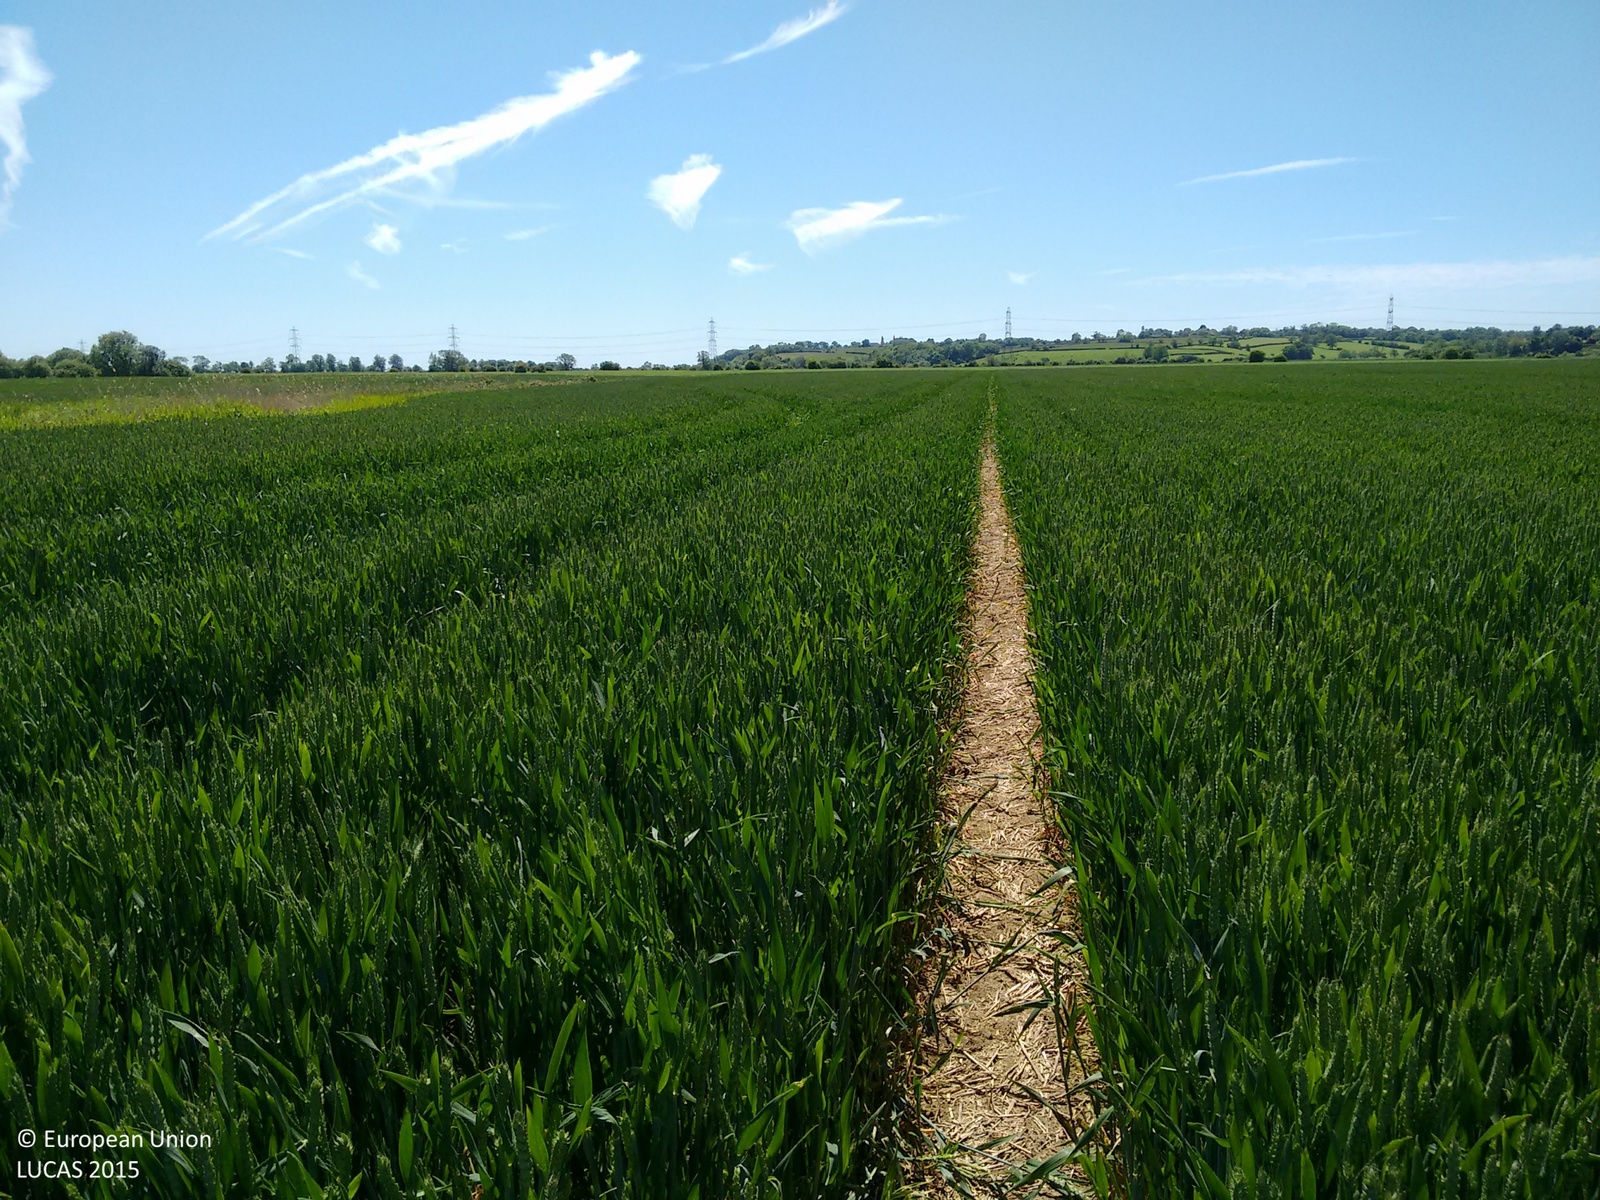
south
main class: Cropland
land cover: Common wheat
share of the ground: > 75 %
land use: Agriculture (excluding fallow land and kitchen gardens)
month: June
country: GB
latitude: 51.0025
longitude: 0.7544
